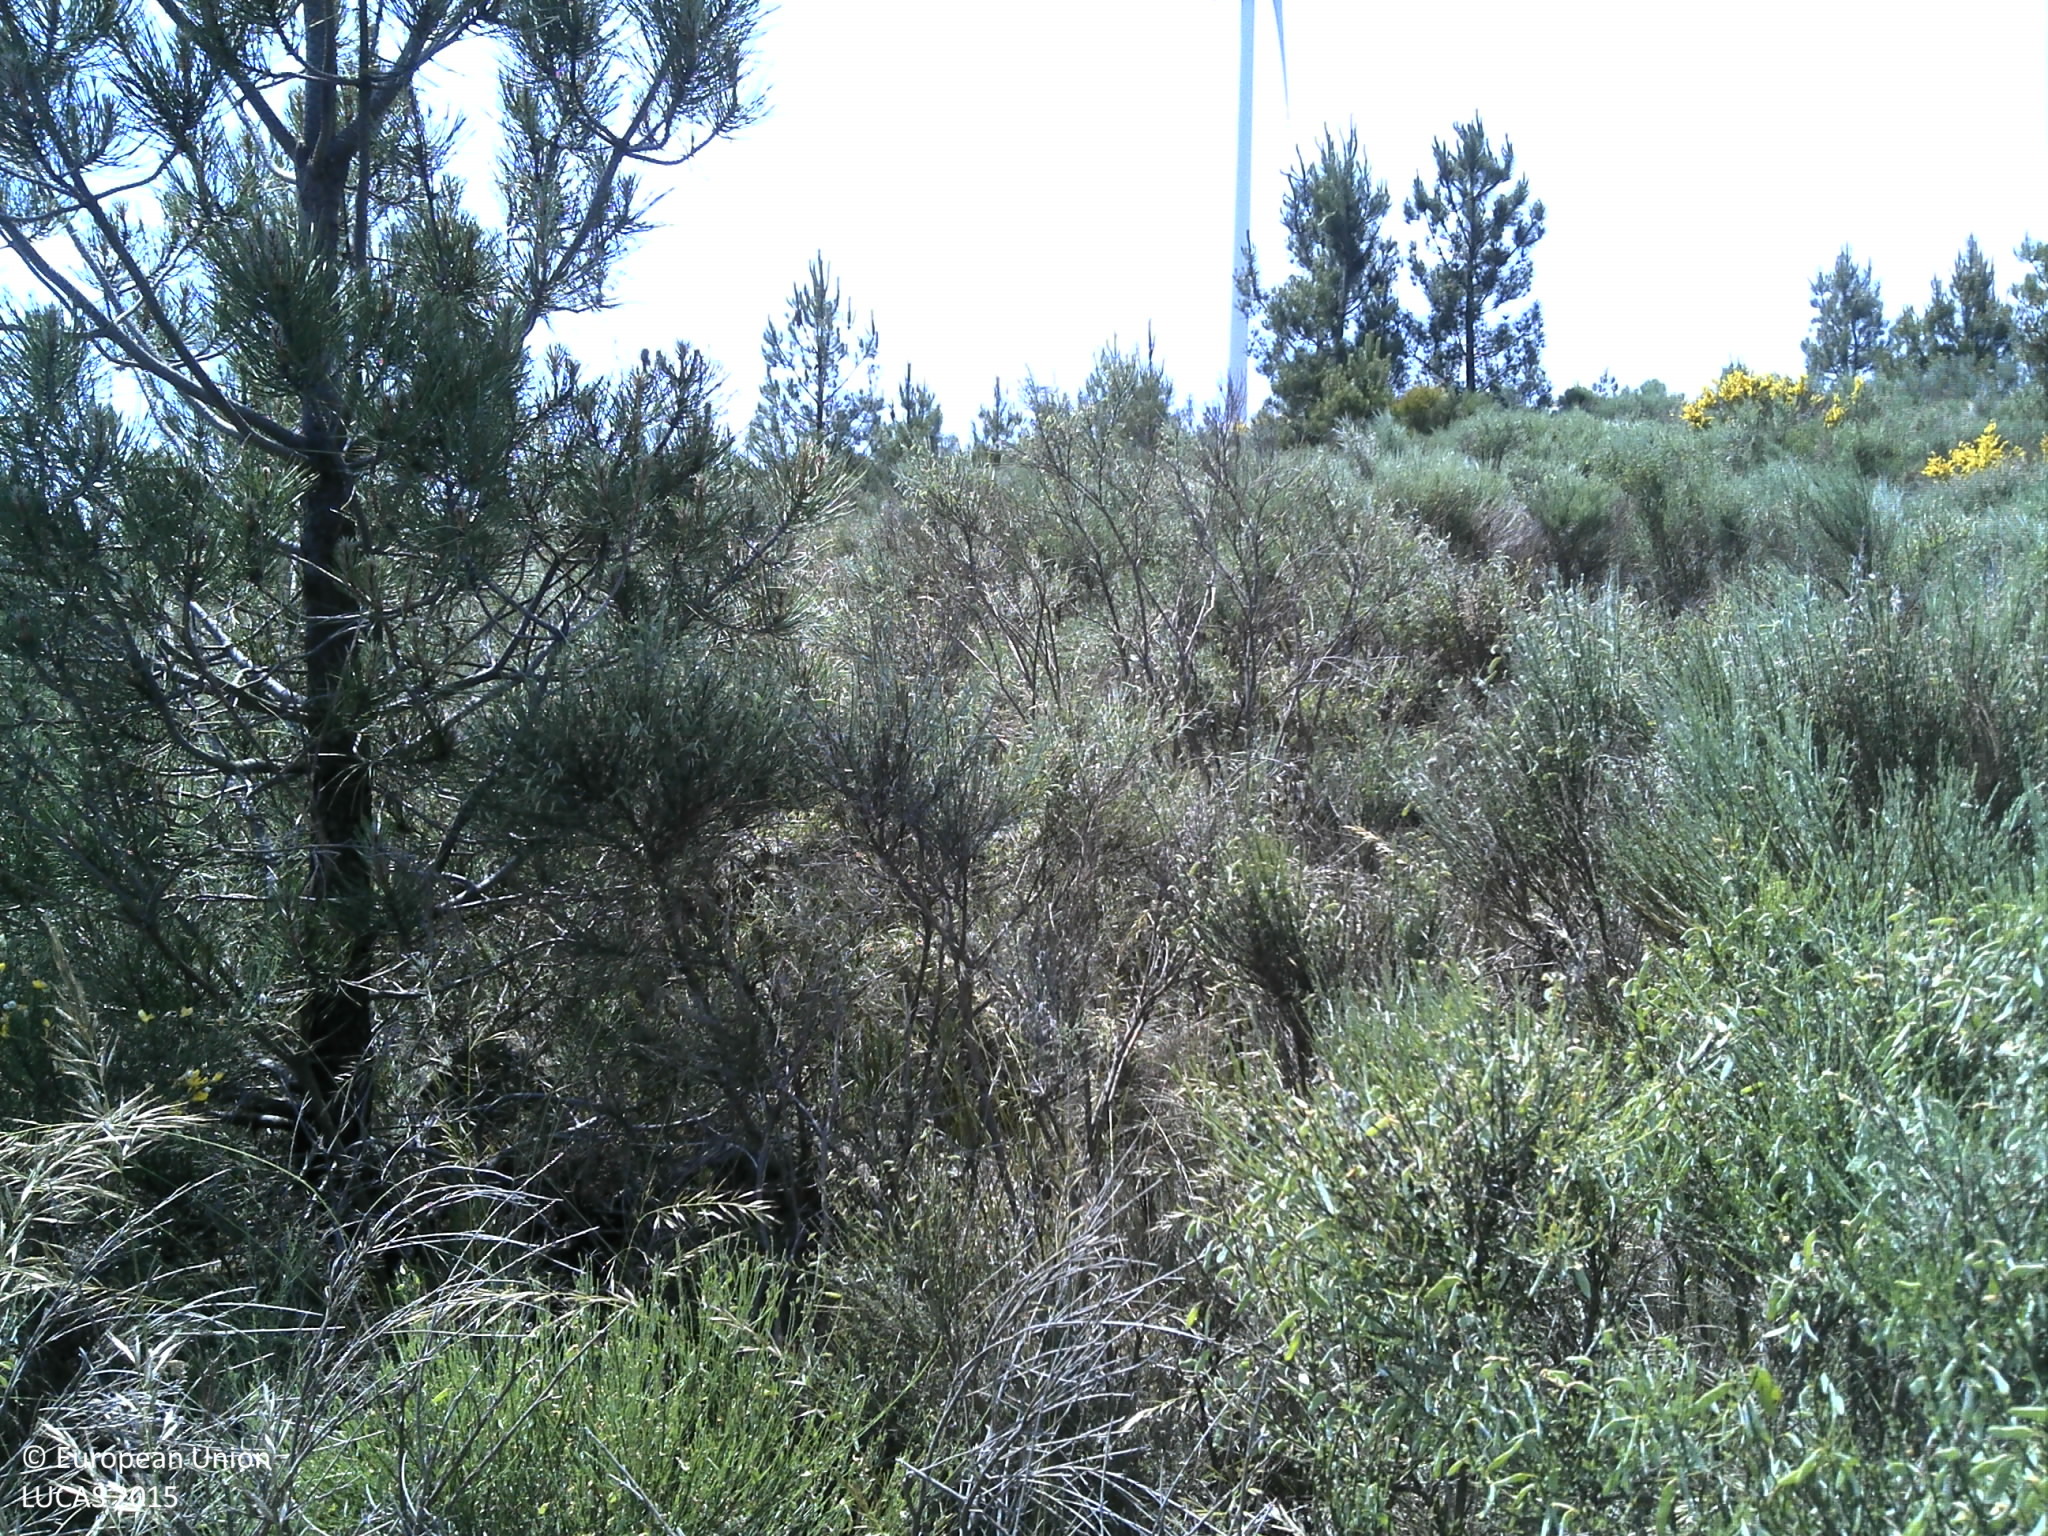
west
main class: Shrubland
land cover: Shrubland with sparse tree cover
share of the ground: > 75 %
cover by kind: shrubs 90 %, coniferous forest trees 5 %, consolidated bare surface 5 %
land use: Forestry
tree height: < 5 m
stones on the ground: < 10 %
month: May
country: PT
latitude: 41.1720
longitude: -6.9751
